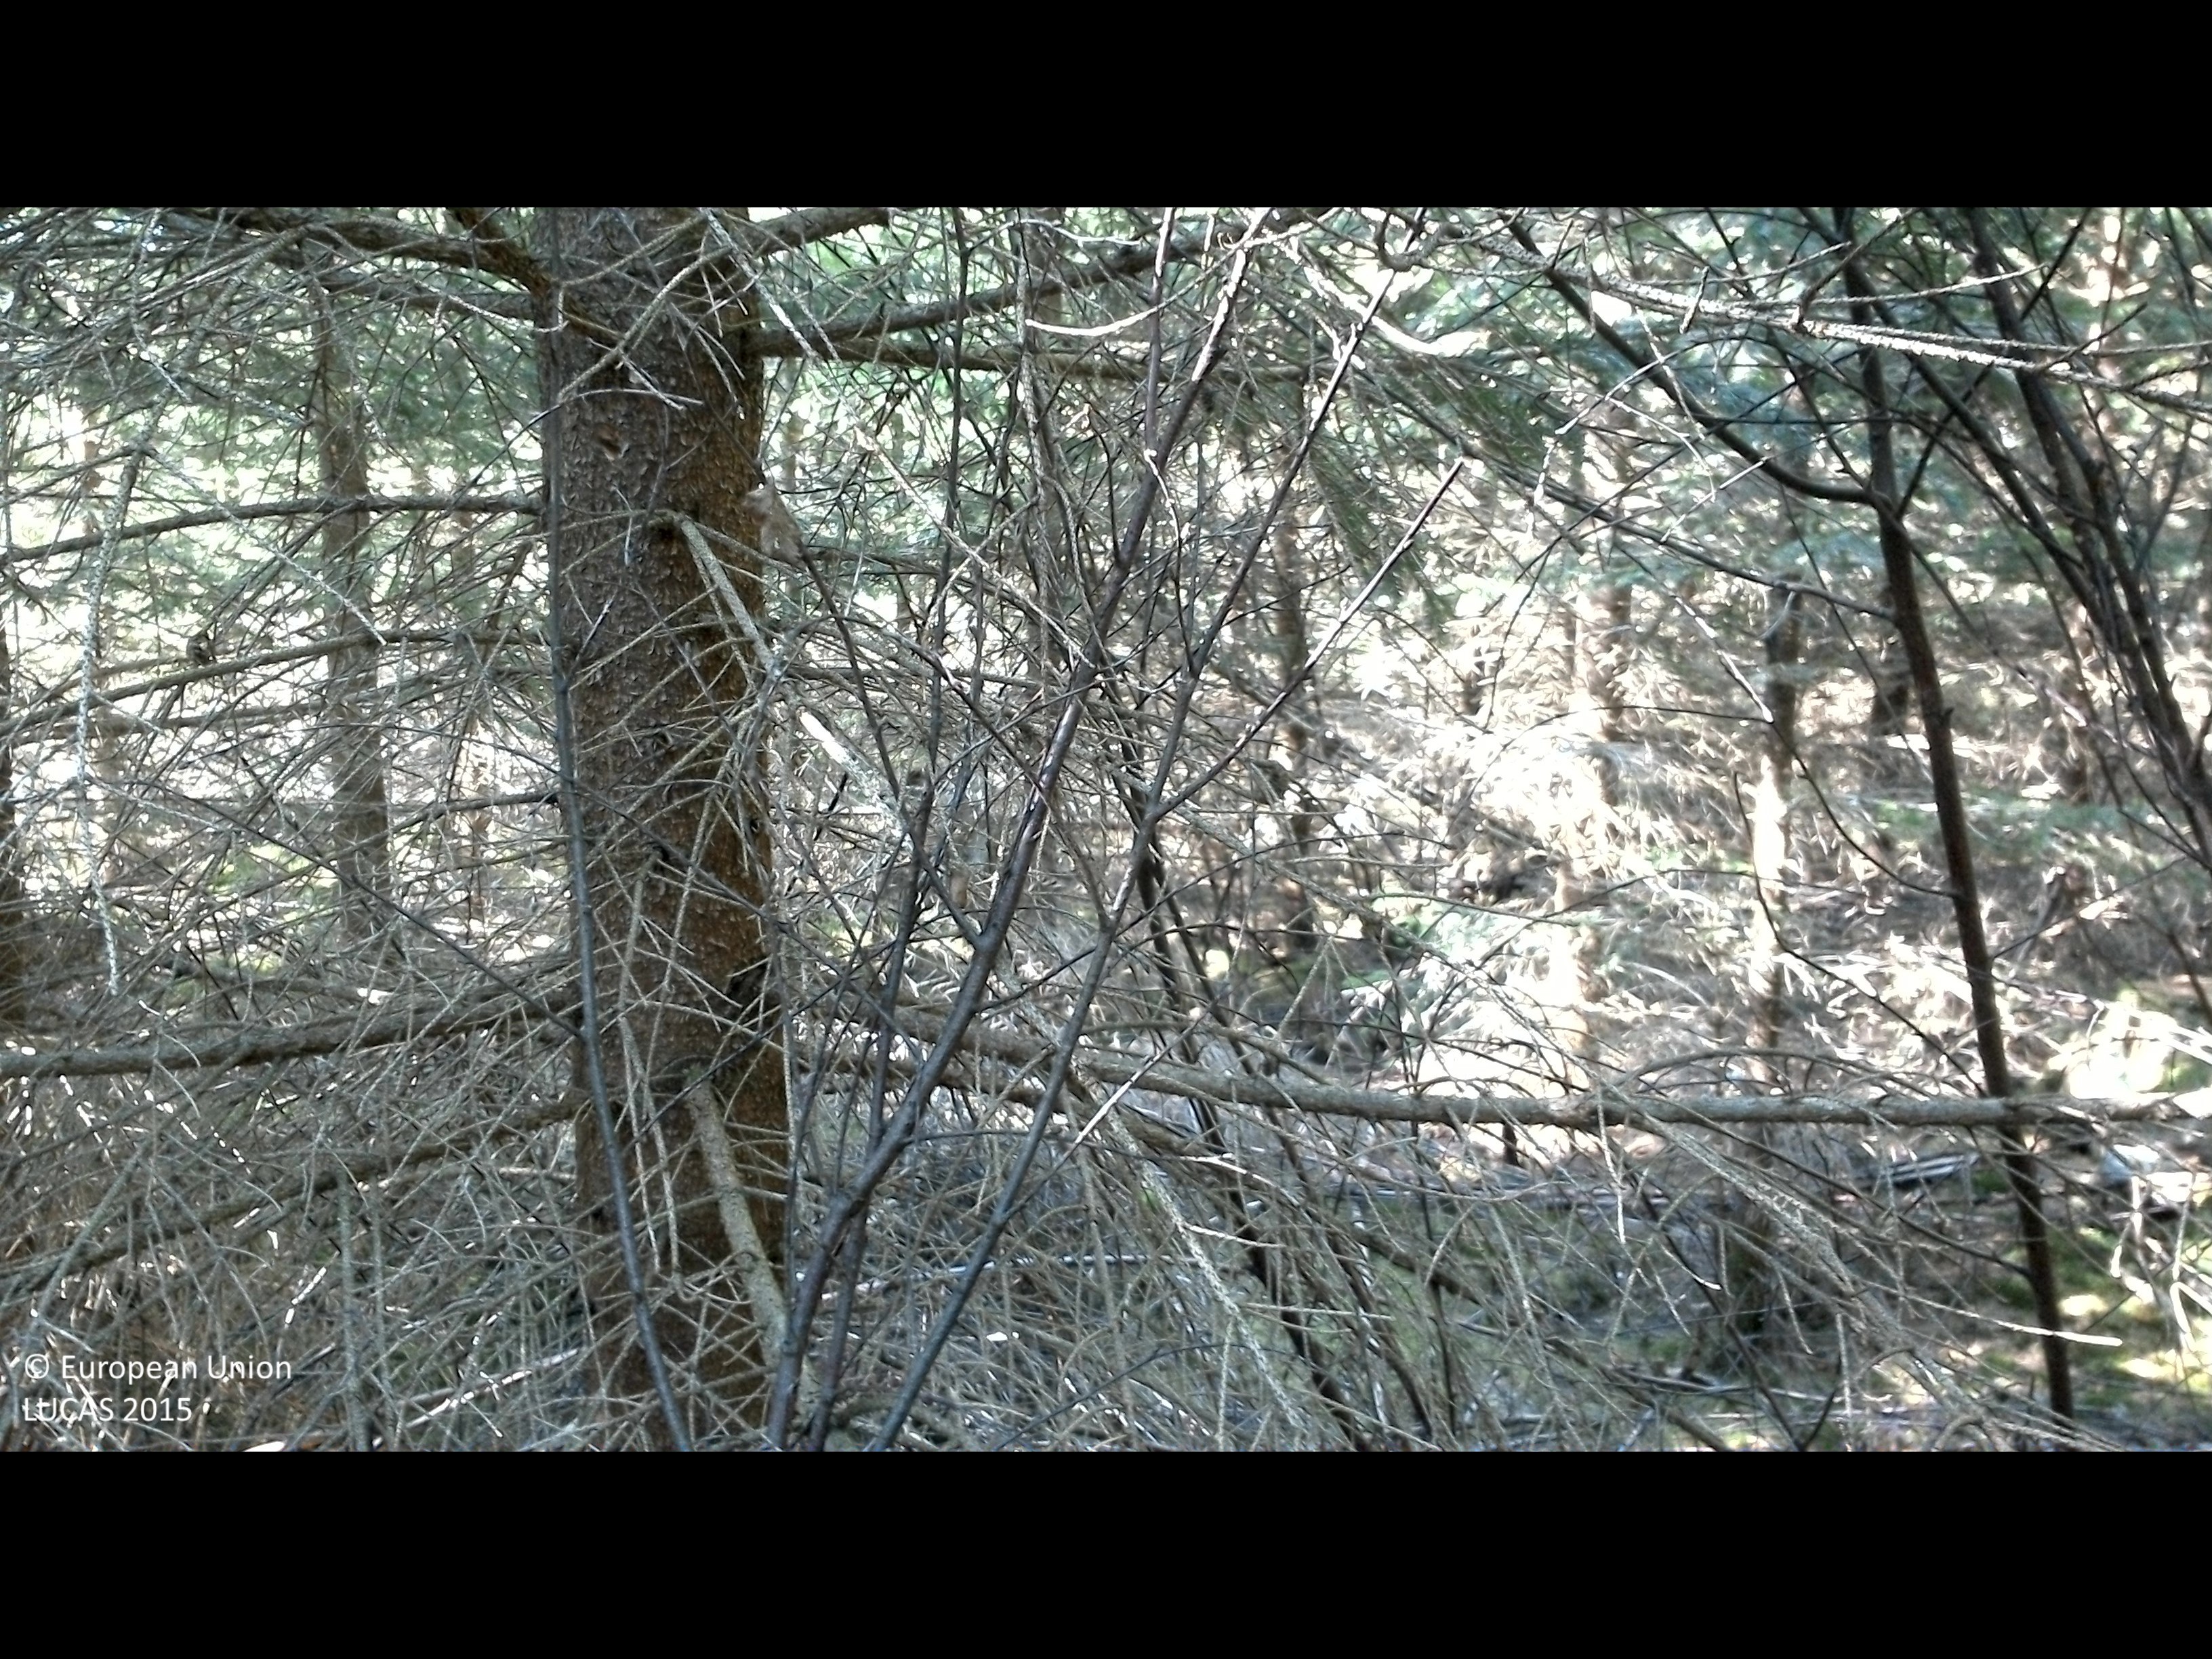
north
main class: Woodland
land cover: Spruce dominated coniferous woodland
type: boreal forest
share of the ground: > 75 %
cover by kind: coniferous forest trees 90 %, lichens and mosses 10 %
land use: Forestry
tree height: > 5 m
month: July
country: SE
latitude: 56.4285
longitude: 15.1061
